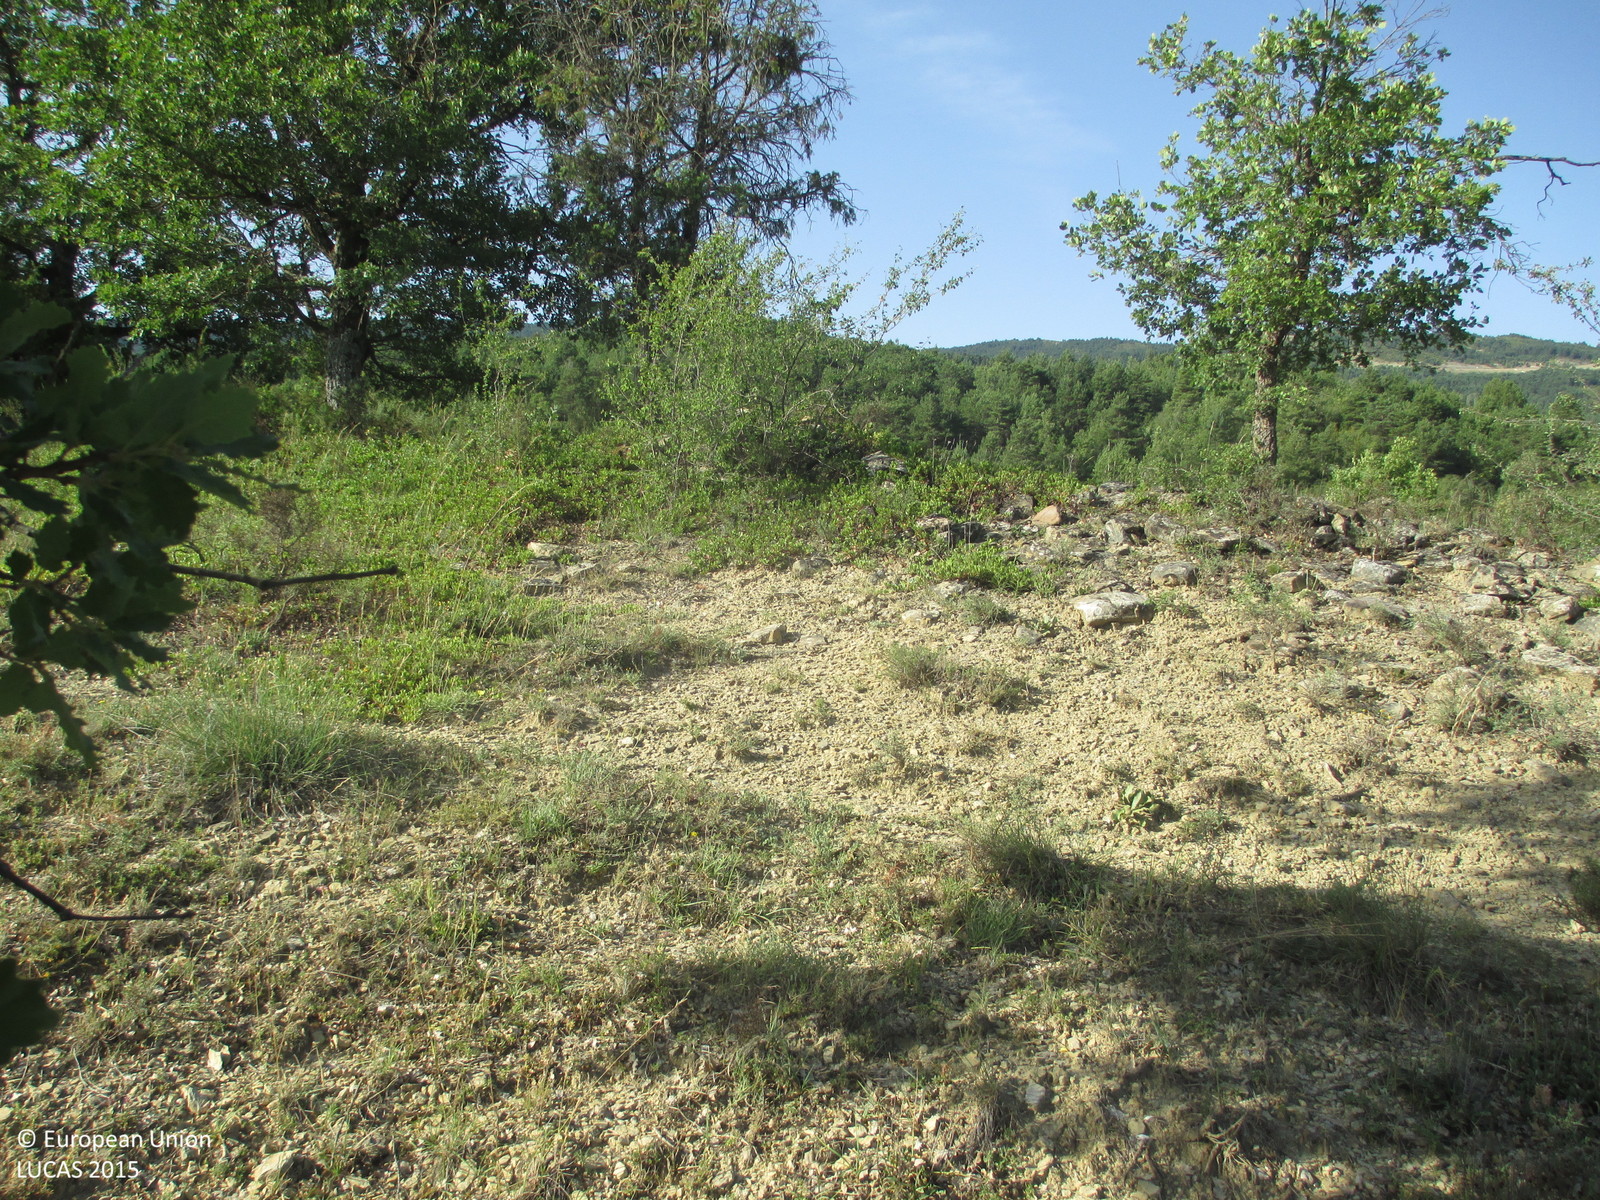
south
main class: Grassland
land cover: Grassland with sparse tree/shrub cover
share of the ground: > 75 %
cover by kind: herbaceous plants 90 %, broadleaved forest trees 5 %, shrubs 5 %
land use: Semi-natural and natural areas not in use
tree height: > 5 m
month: July
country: ES
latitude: 42.3762
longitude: -0.3592
